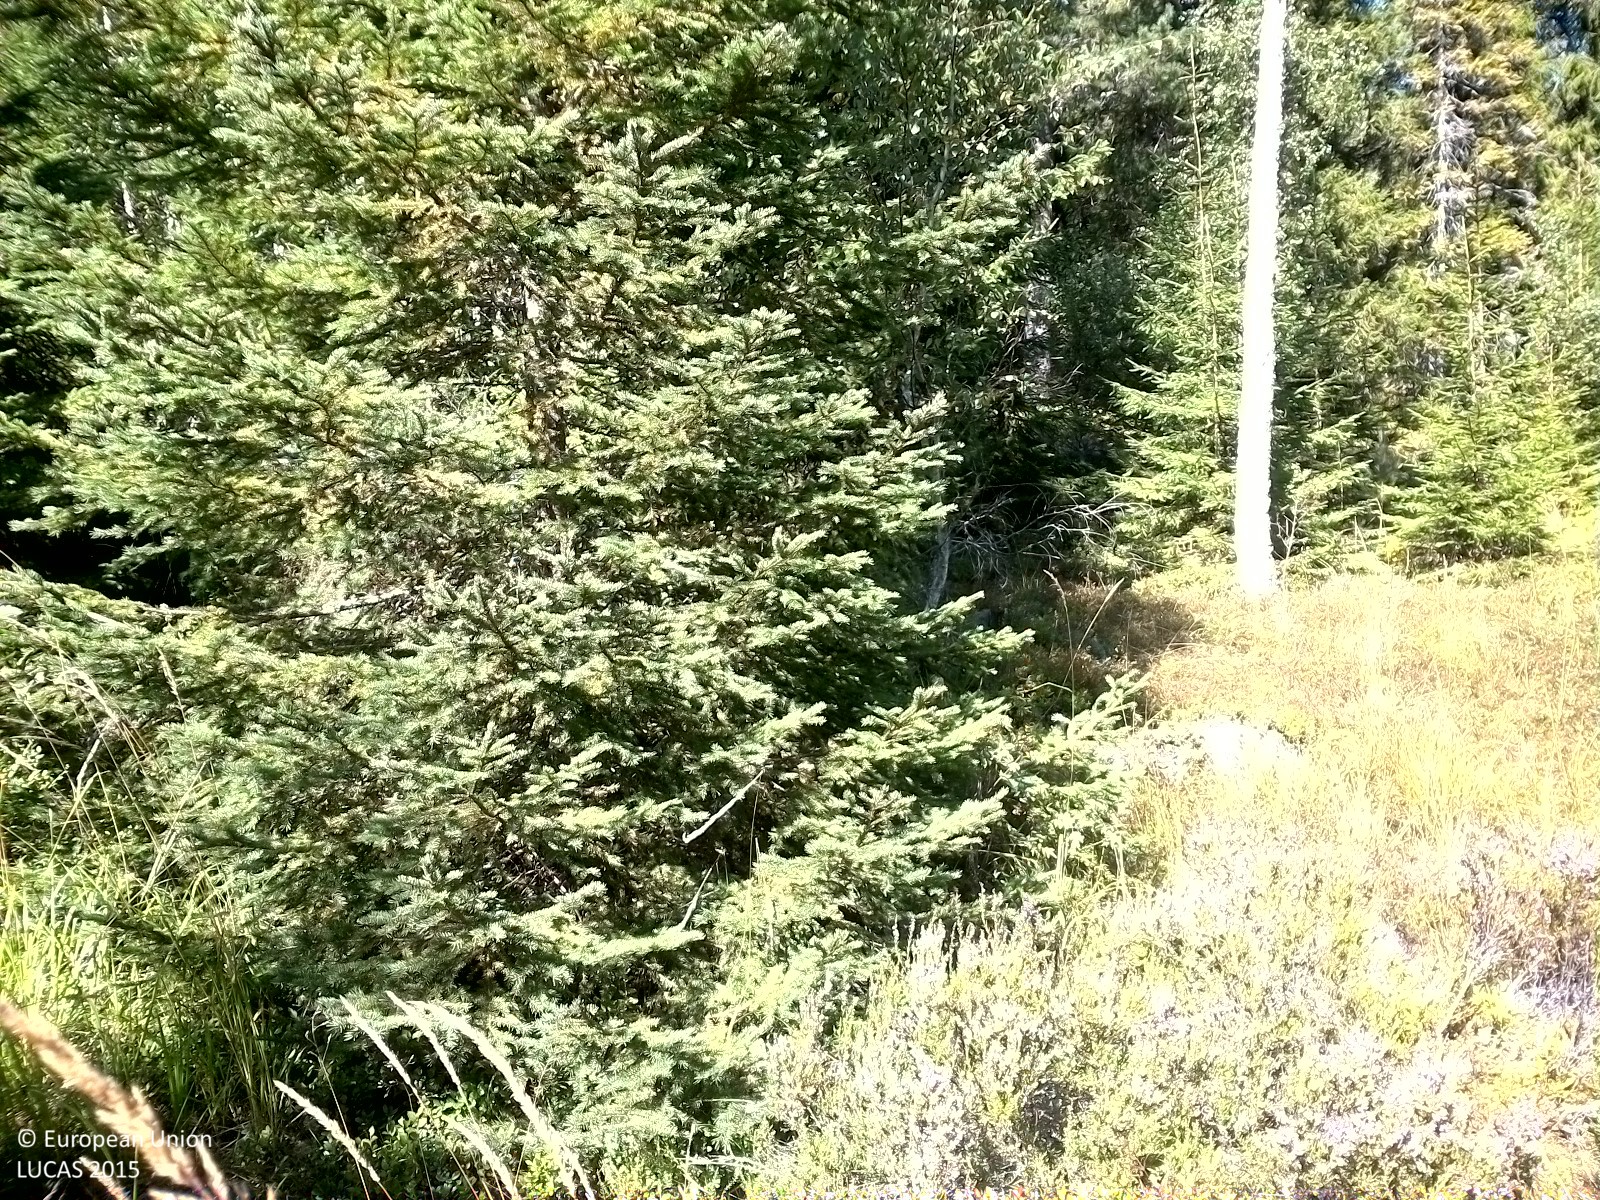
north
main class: Woodland
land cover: Spruce dominated mixed woodland
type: boreal forest
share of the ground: 25 - 50 %
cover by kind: herbaceous plants 30 %, shrubs 25 %, coniferous forest trees 20 %, broadleaved forest trees 15 %, lichens and mosses 10 %
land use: Forestry
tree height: < 5 m
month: August
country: SE
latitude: 59.4037
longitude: 15.0817
